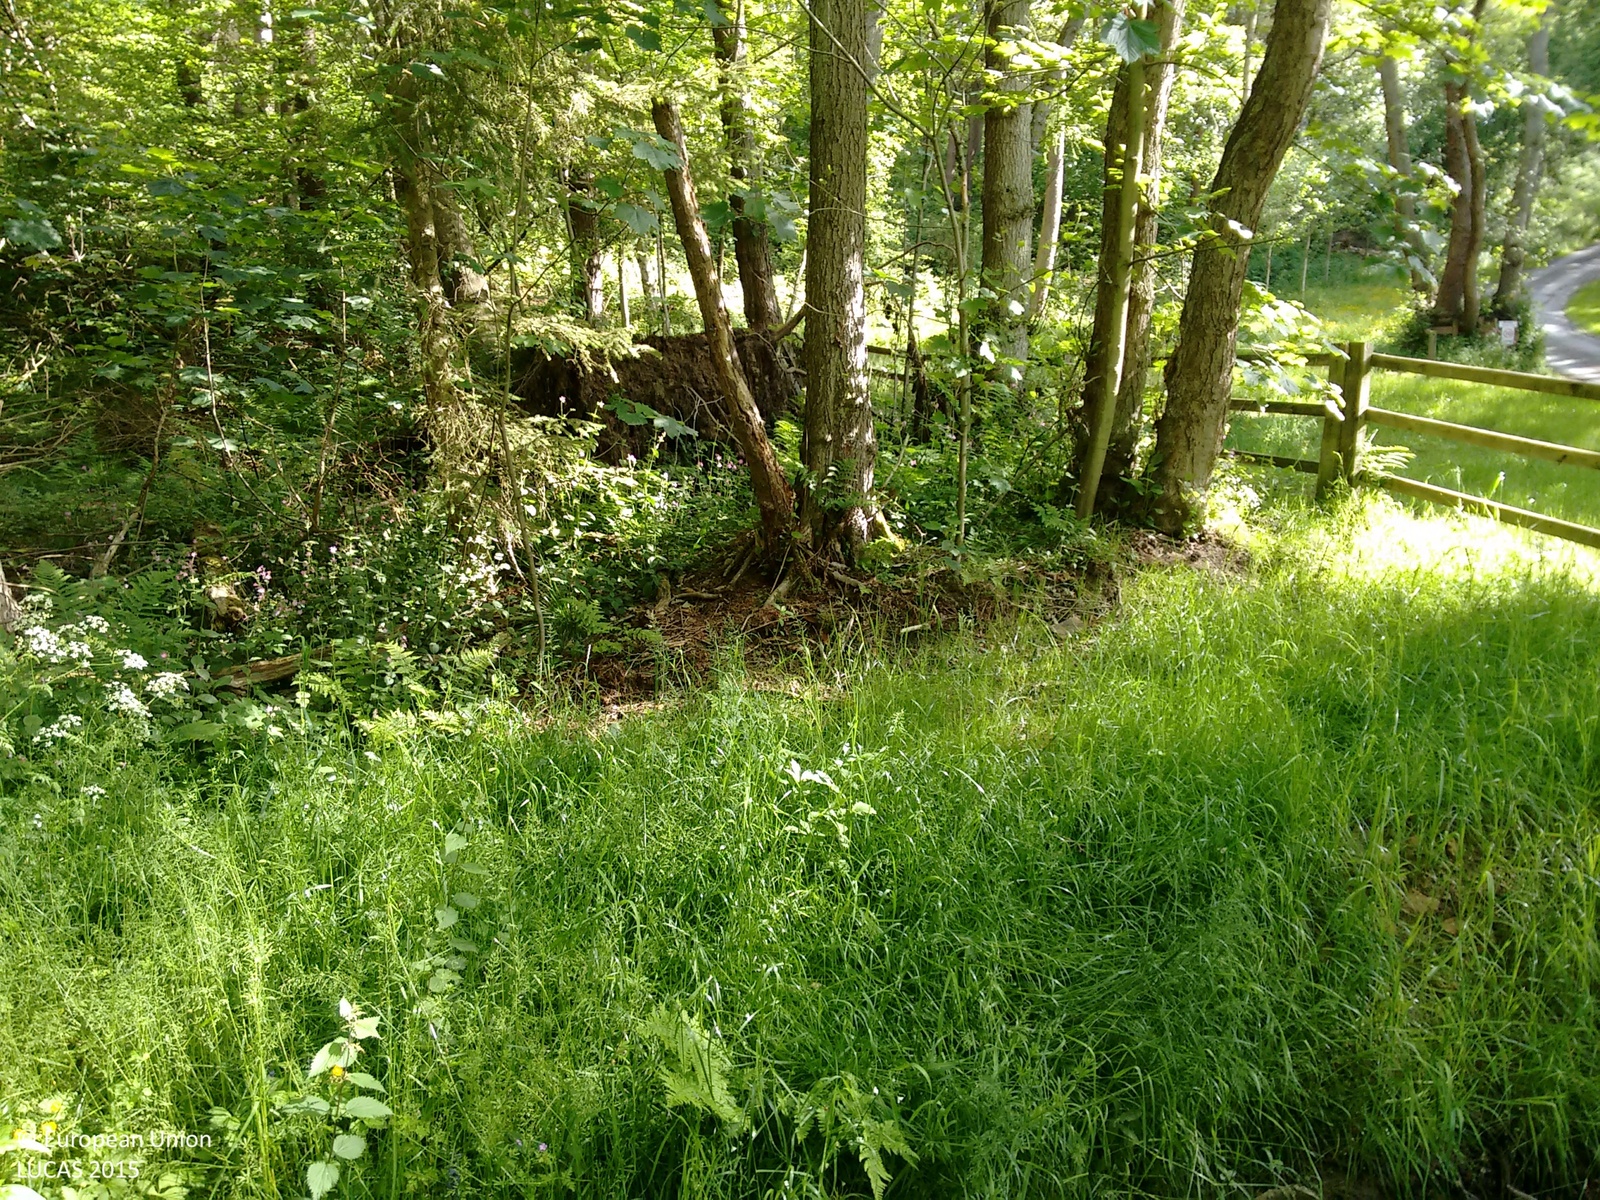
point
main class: Woodland
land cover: Broadleaved woodland
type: mesophytic deciduous forest
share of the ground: > 75 %
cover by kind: broadleaved forest trees 80 %, coniferous forest trees 20 %
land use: Sport
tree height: > 5 m
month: June
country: GB
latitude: 54.1471
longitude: -1.0507
